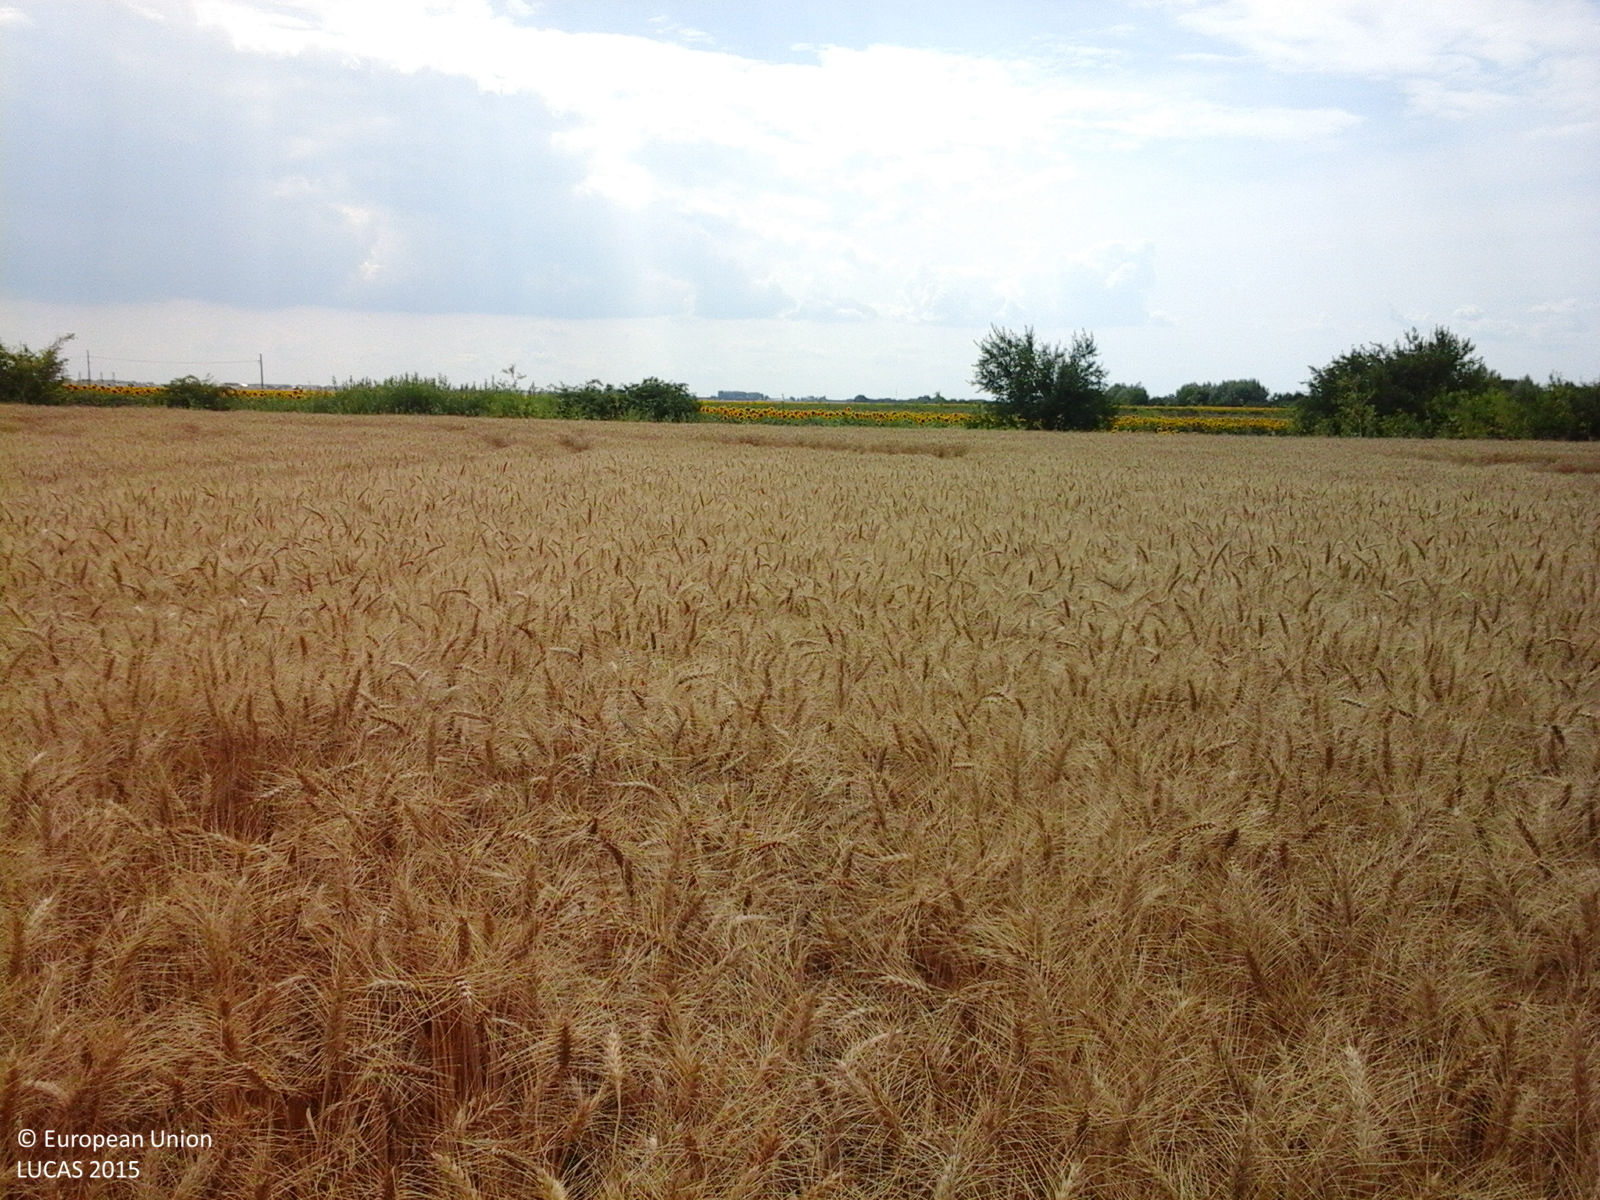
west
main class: Cropland
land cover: Common wheat
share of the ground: > 75 %
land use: Agriculture (excluding fallow land and kitchen gardens)
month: June
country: RO
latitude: 44.5651
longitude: 26.1356
